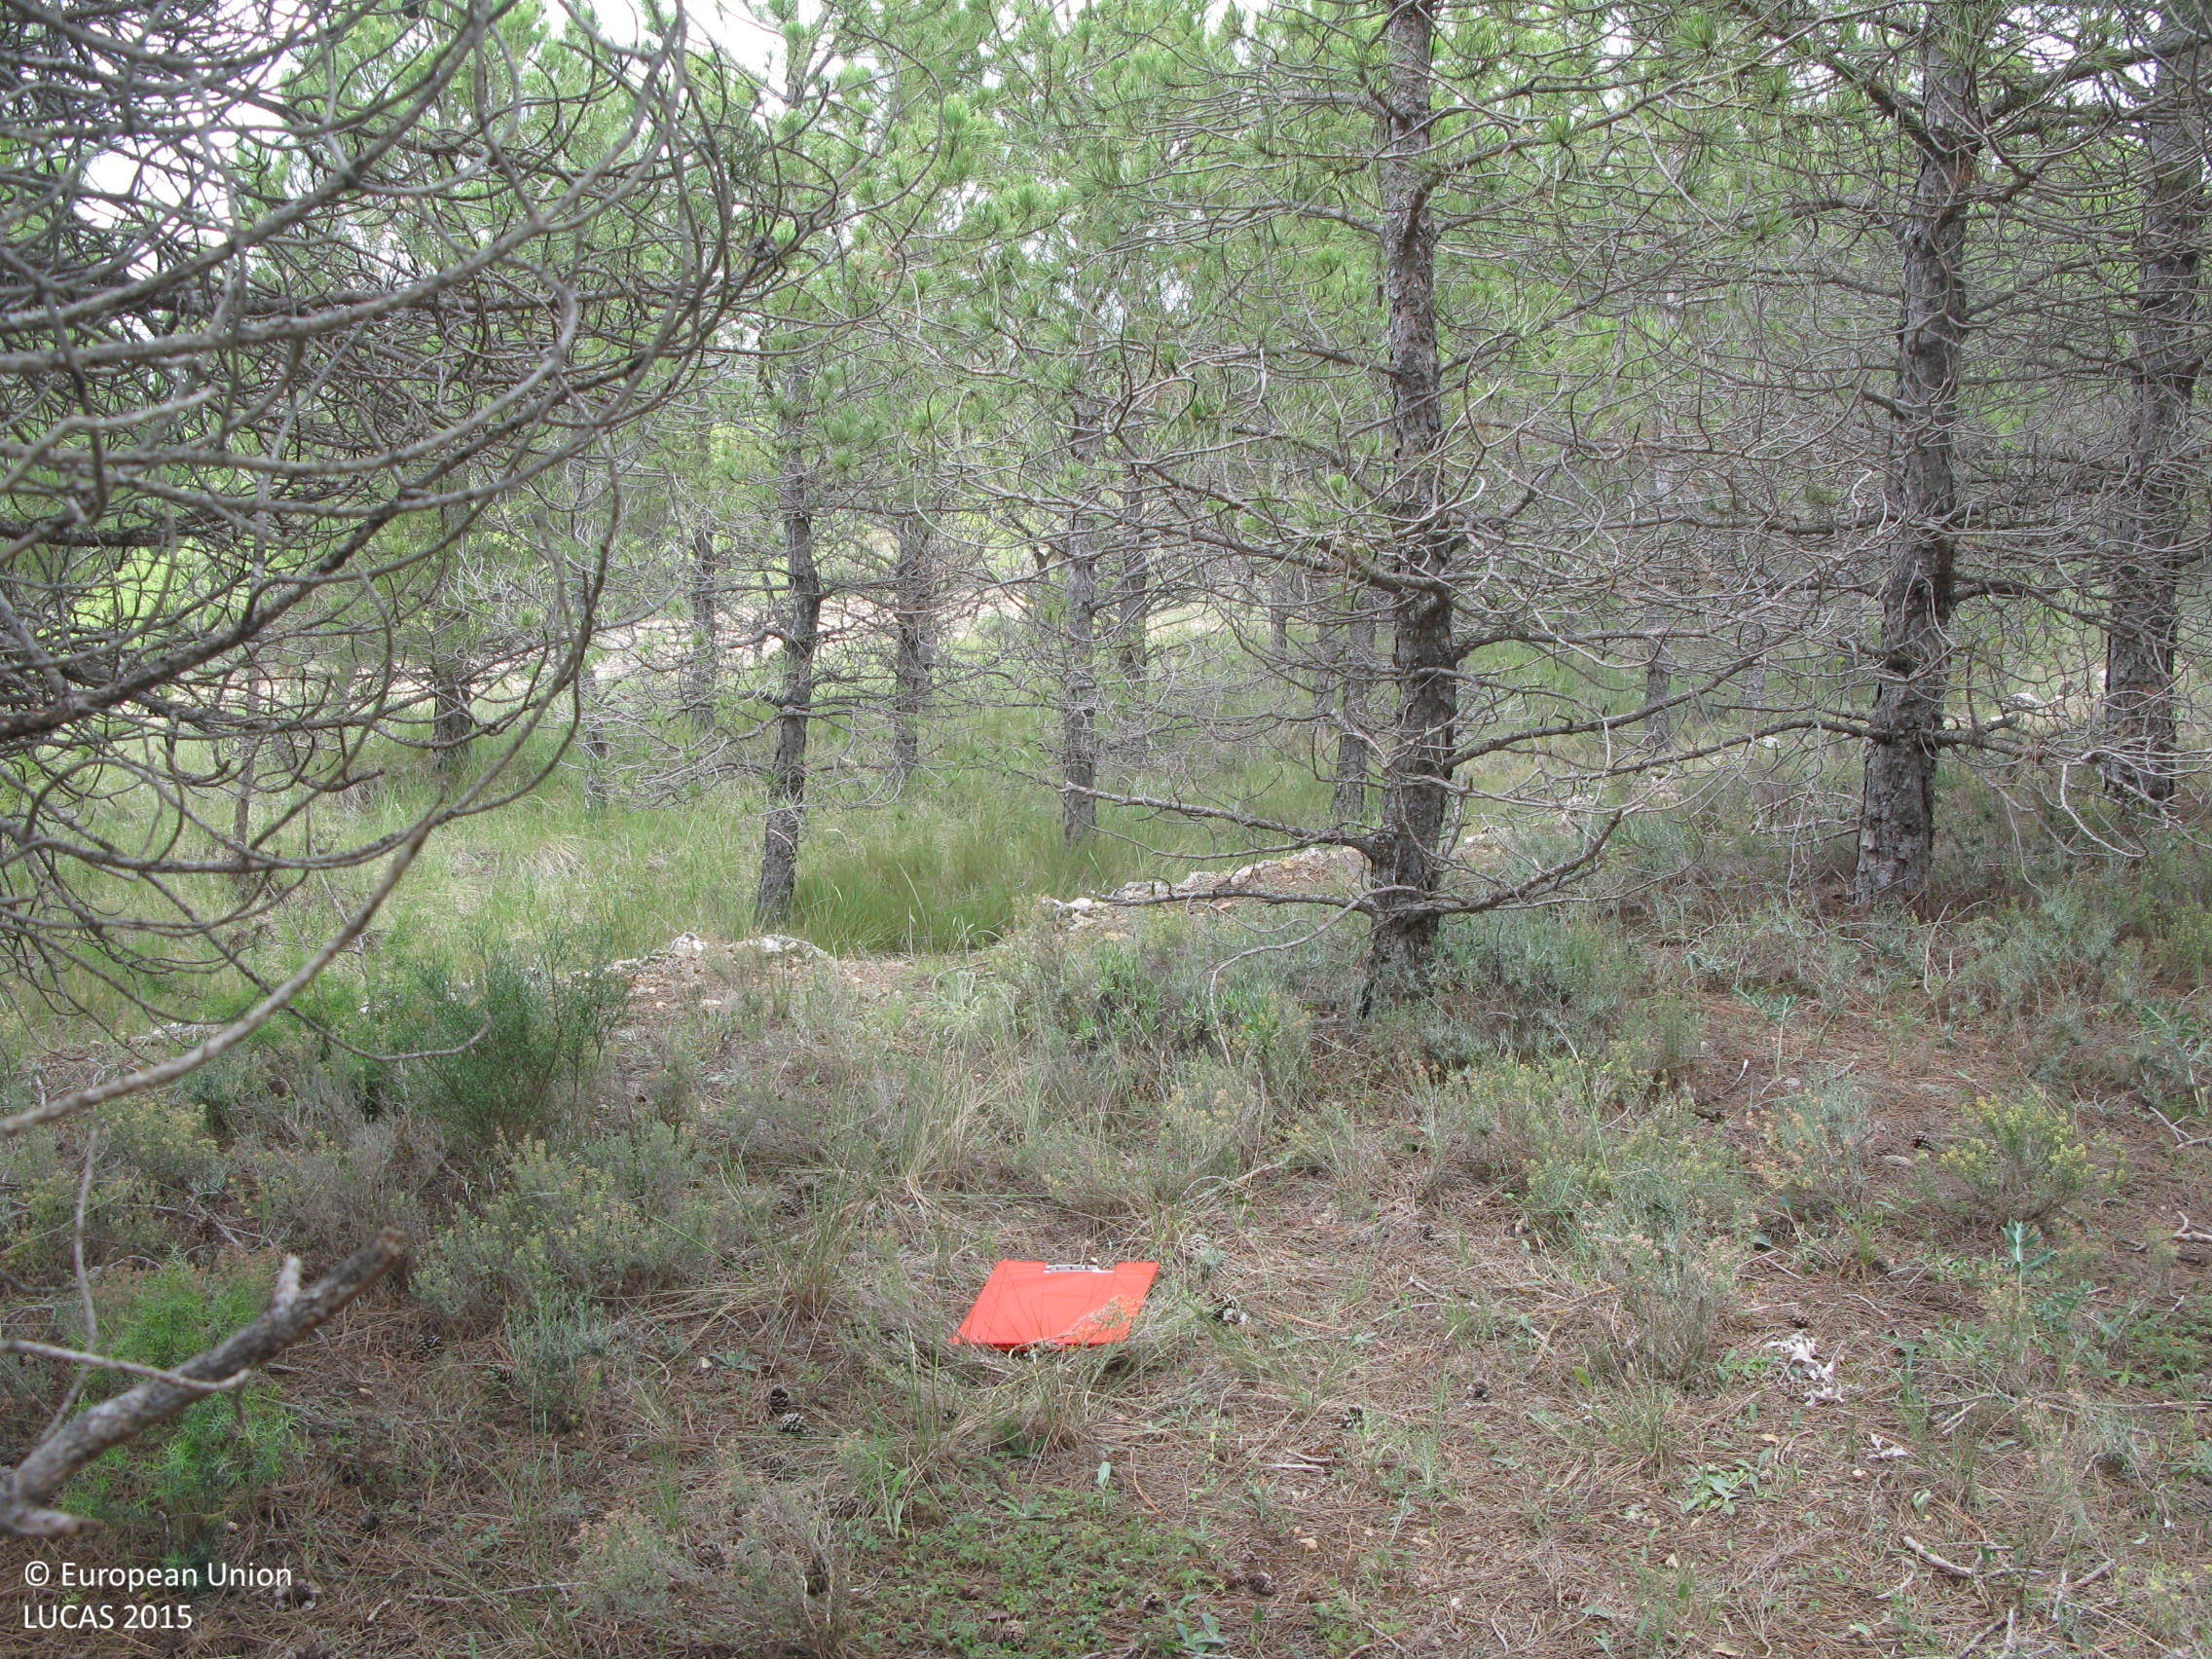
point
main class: Woodland
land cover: Pine dominated coniferous woodland
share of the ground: > 75 %
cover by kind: coniferous forest trees 80 %, herbaceous plants 20 %
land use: Forestry
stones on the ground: 10 - 25 %
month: June
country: ES
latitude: 40.0408
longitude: -1.2245
